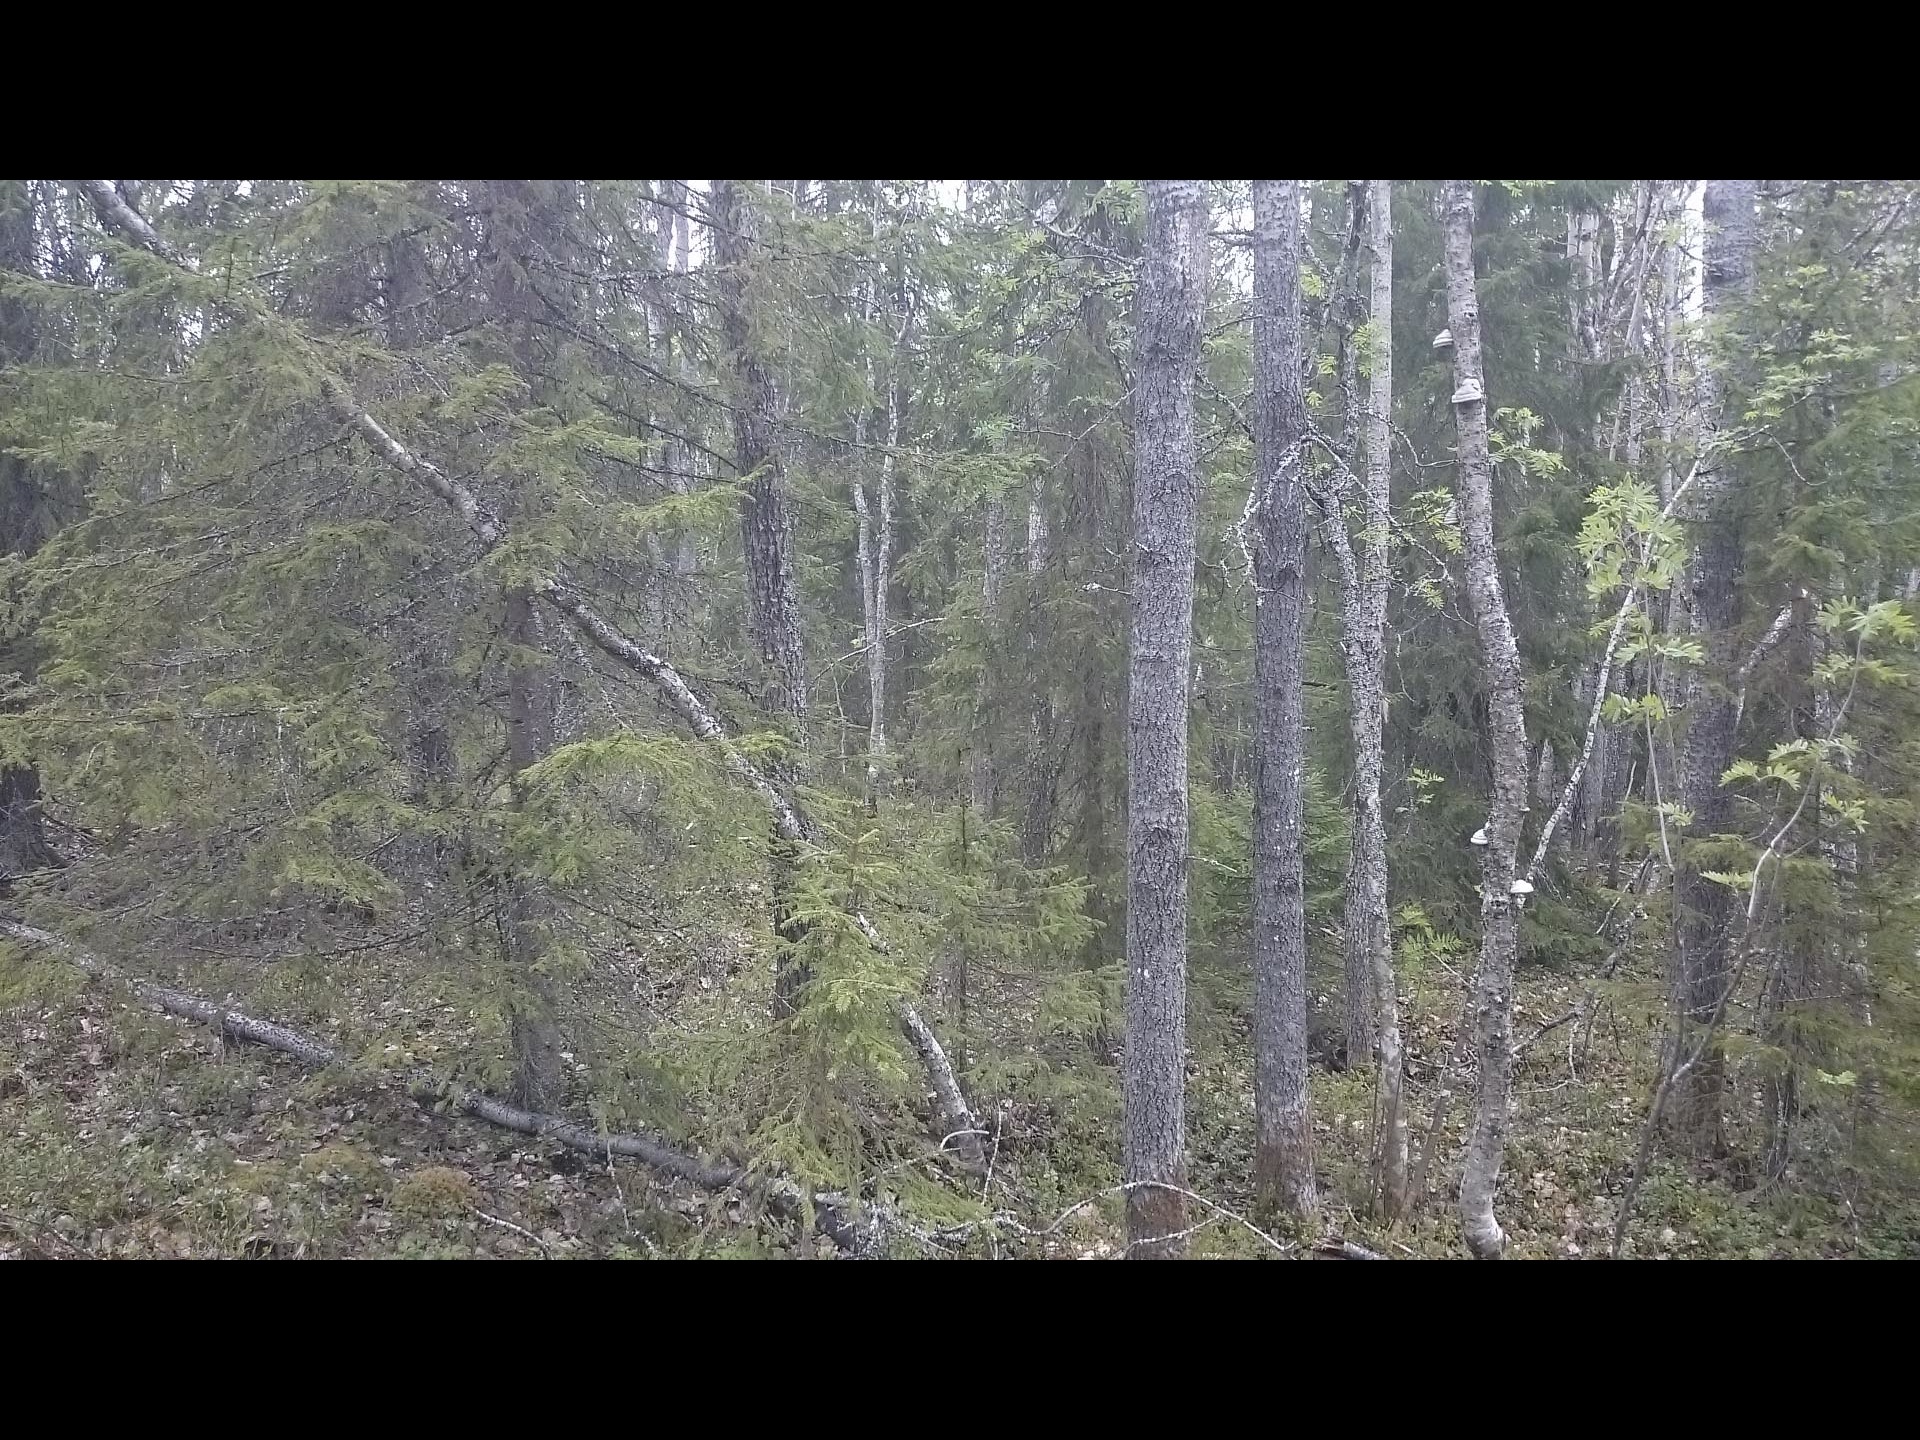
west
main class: Woodland
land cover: Spruce dominated mixed woodland
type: boreal forest
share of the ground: > 75 %
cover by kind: coniferous forest trees 60 %, broadleaved forest trees 20 %, shrubs 15 %, herbaceous plants 5 %
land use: Forestry
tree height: > 5 m
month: June
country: SE
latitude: 63.6469
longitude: 13.8363
